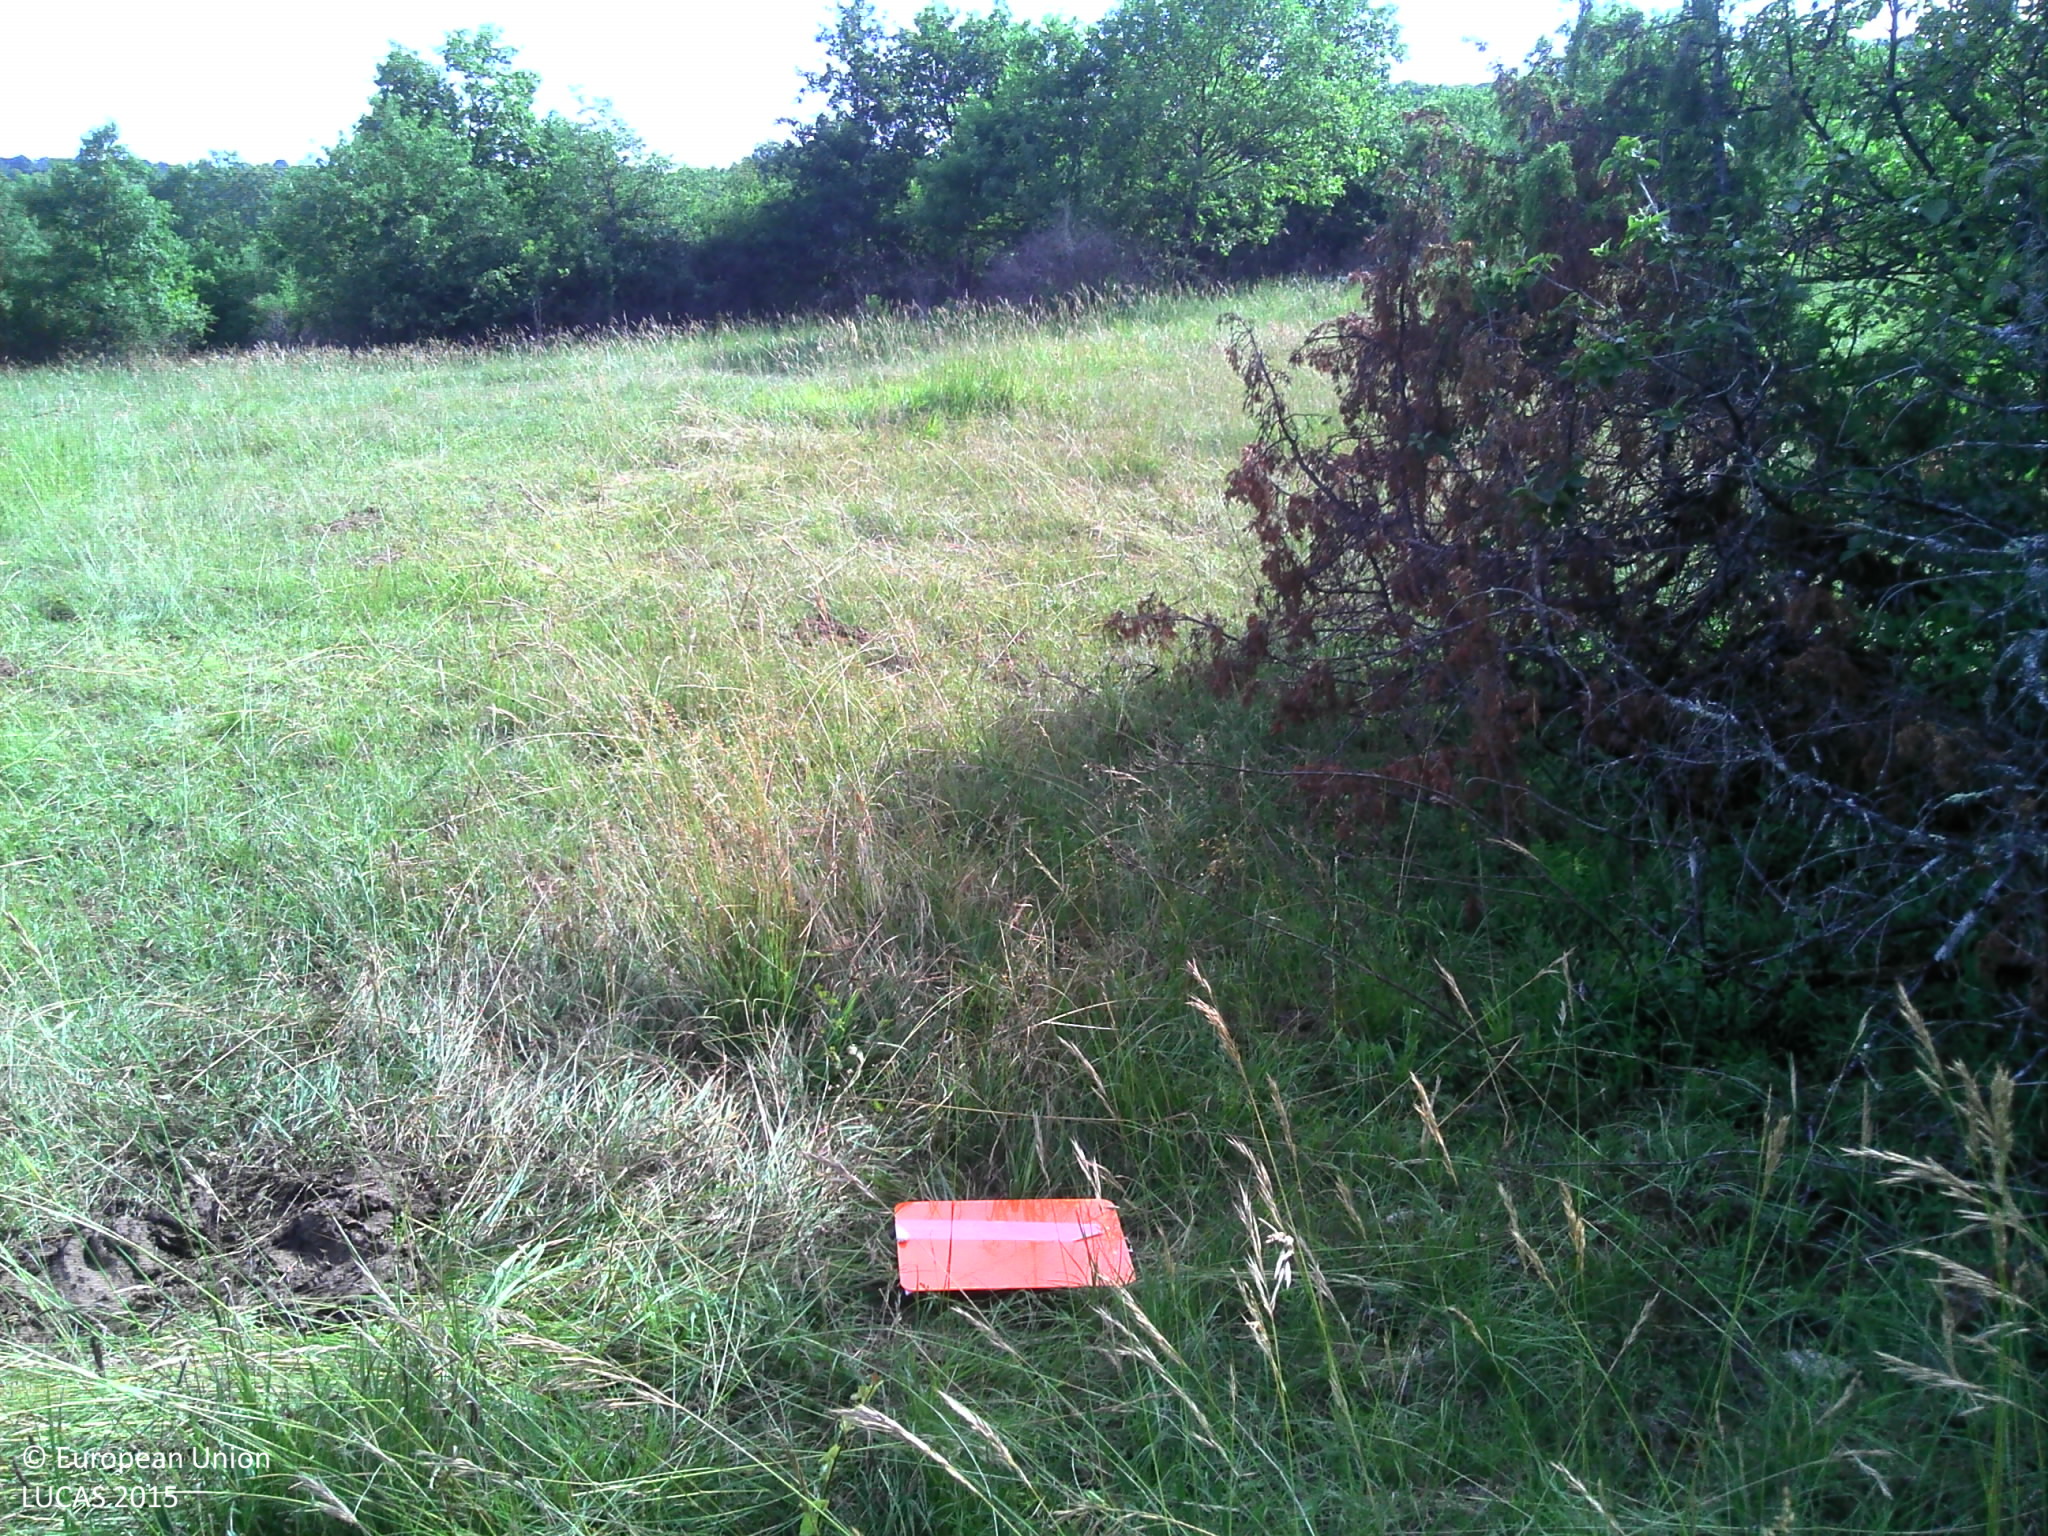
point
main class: Grassland
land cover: Grassland with sparse tree/shrub cover
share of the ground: > 75 %
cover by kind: herbaceous plants 95 %, broadleaved forest trees 5 %
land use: Agriculture (excluding fallow land and kitchen gardens)
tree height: < 5 m
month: June
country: FR
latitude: 46.3601
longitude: 5.3889
